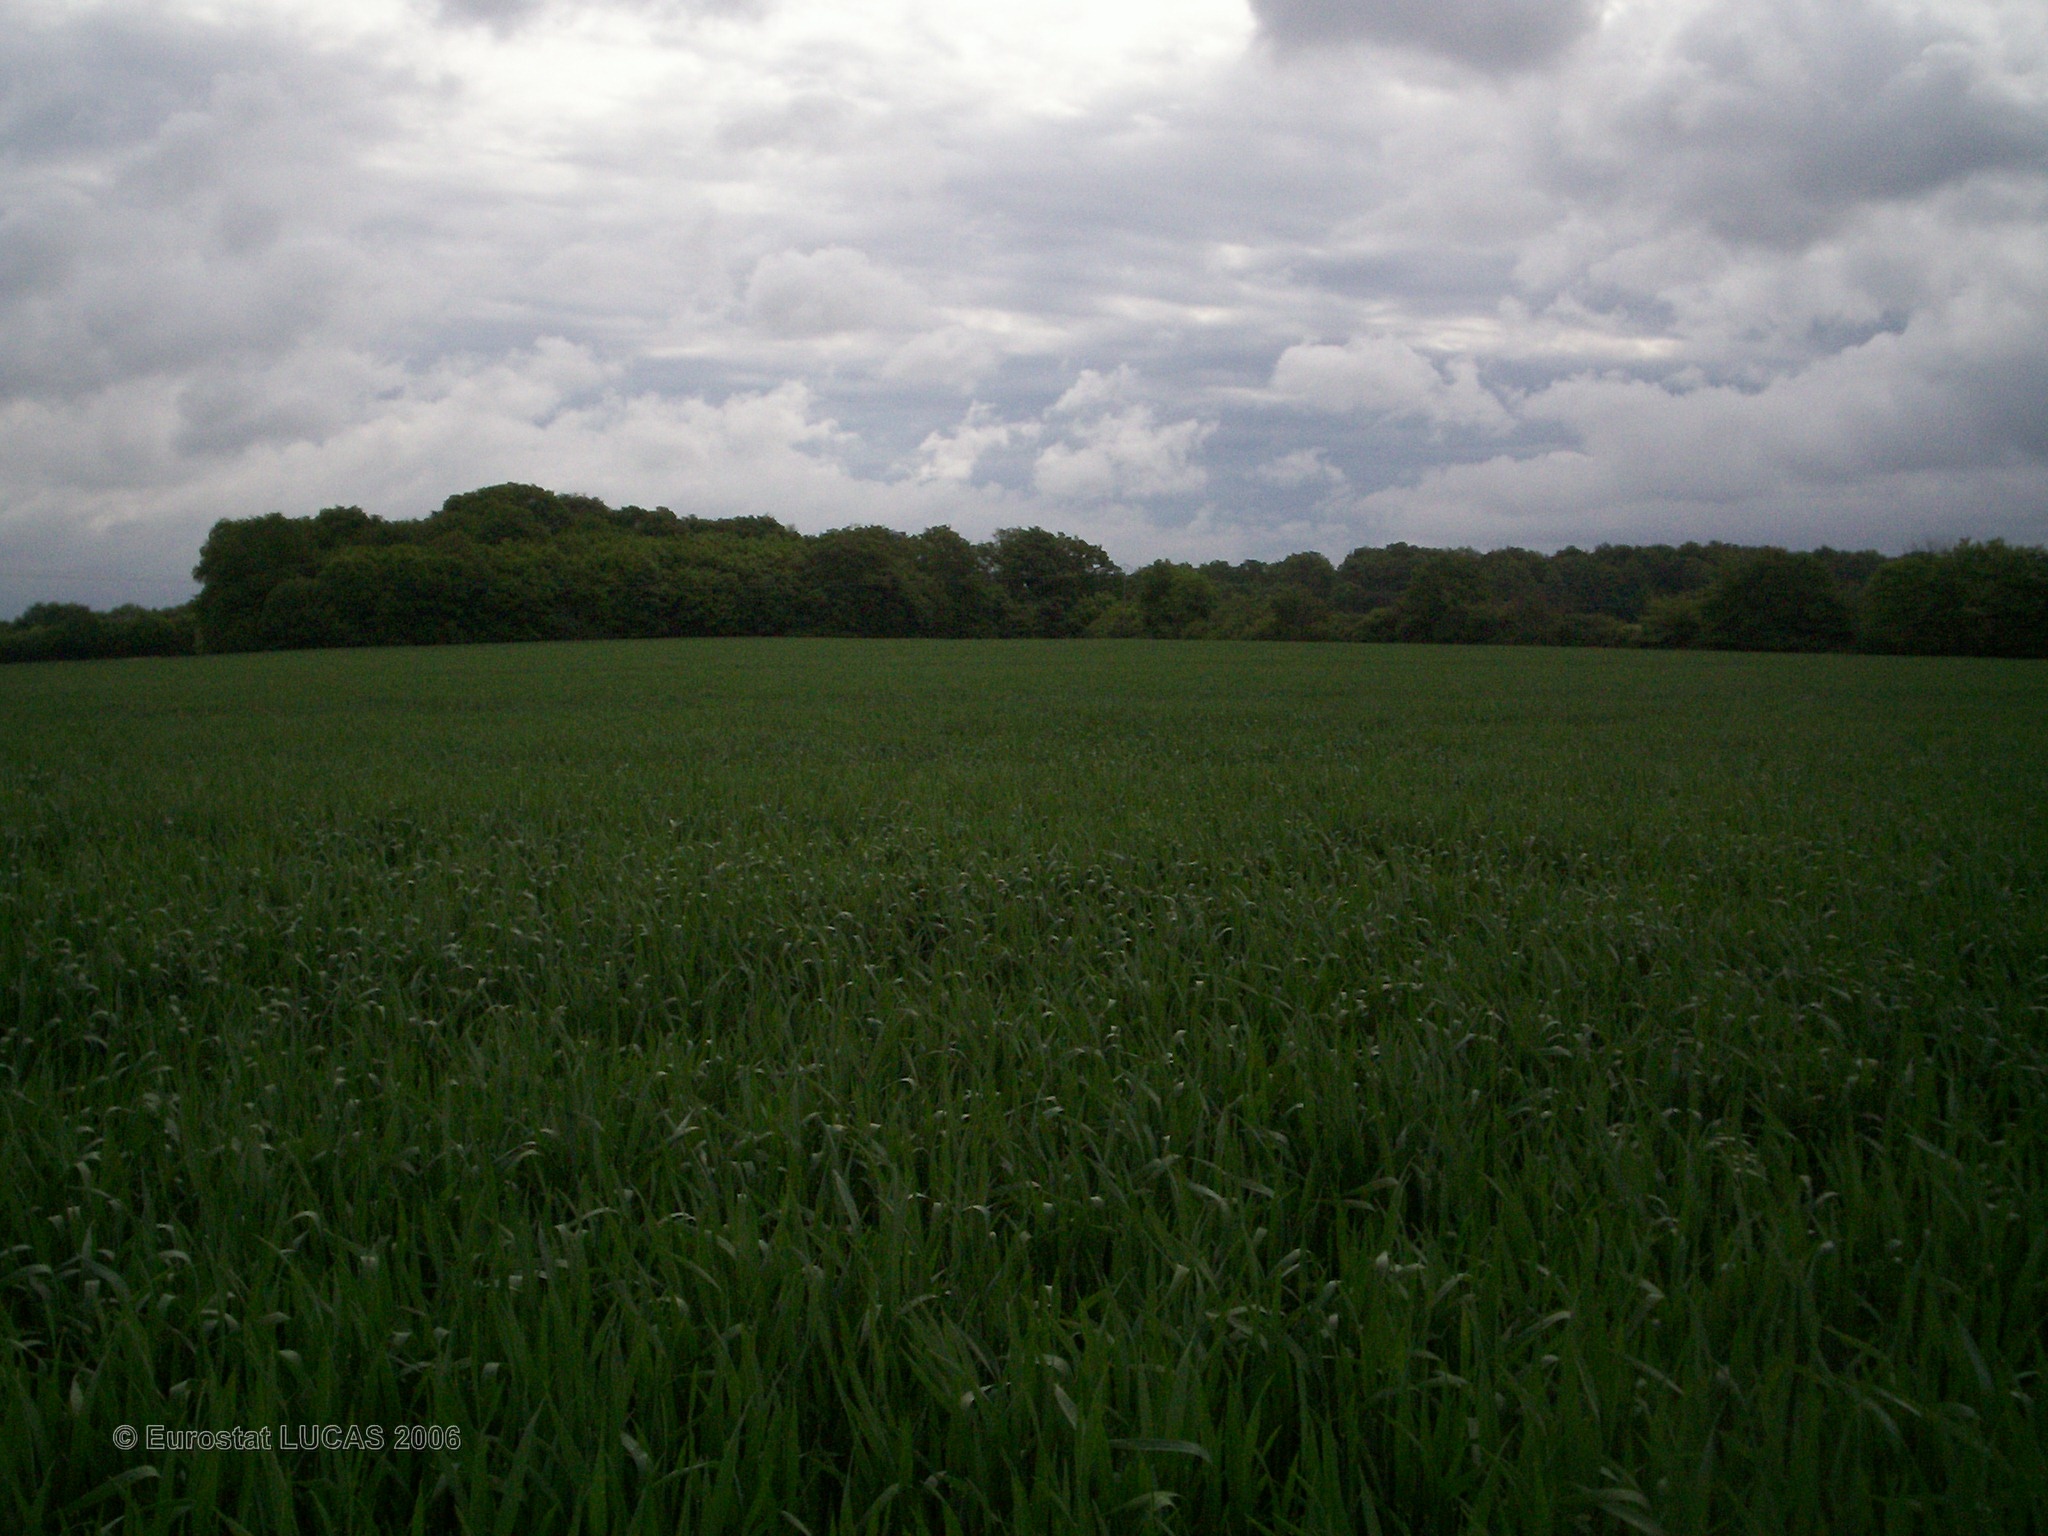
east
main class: Cropland
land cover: Common wheat
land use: Agriculture (excluding fallow land and kitchen gardens)
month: May
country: FR
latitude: 47.7244
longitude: 2.9140
